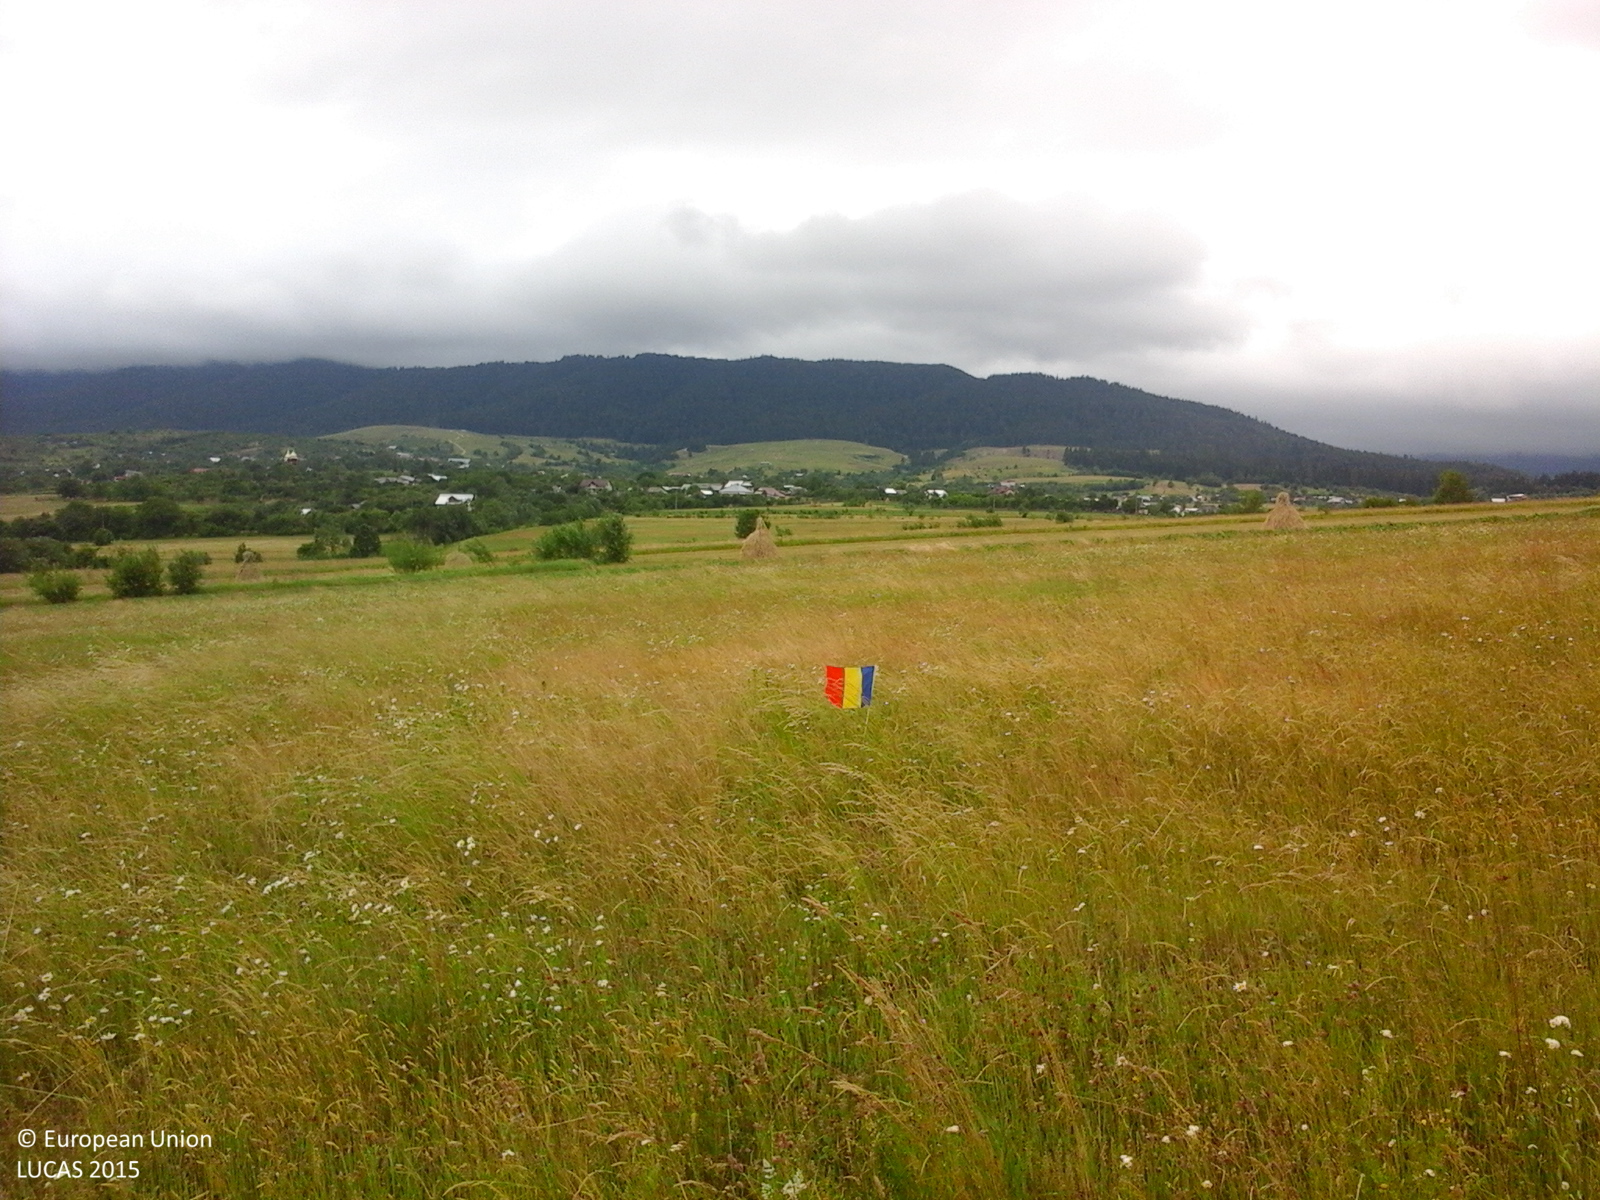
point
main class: Grassland
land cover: Grassland without tree/shrub cover
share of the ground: > 75 %
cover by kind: herbaceous plants 100 %
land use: Agriculture (excluding fallow land and kitchen gardens)
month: June
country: RO
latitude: 47.1656
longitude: 26.2939
